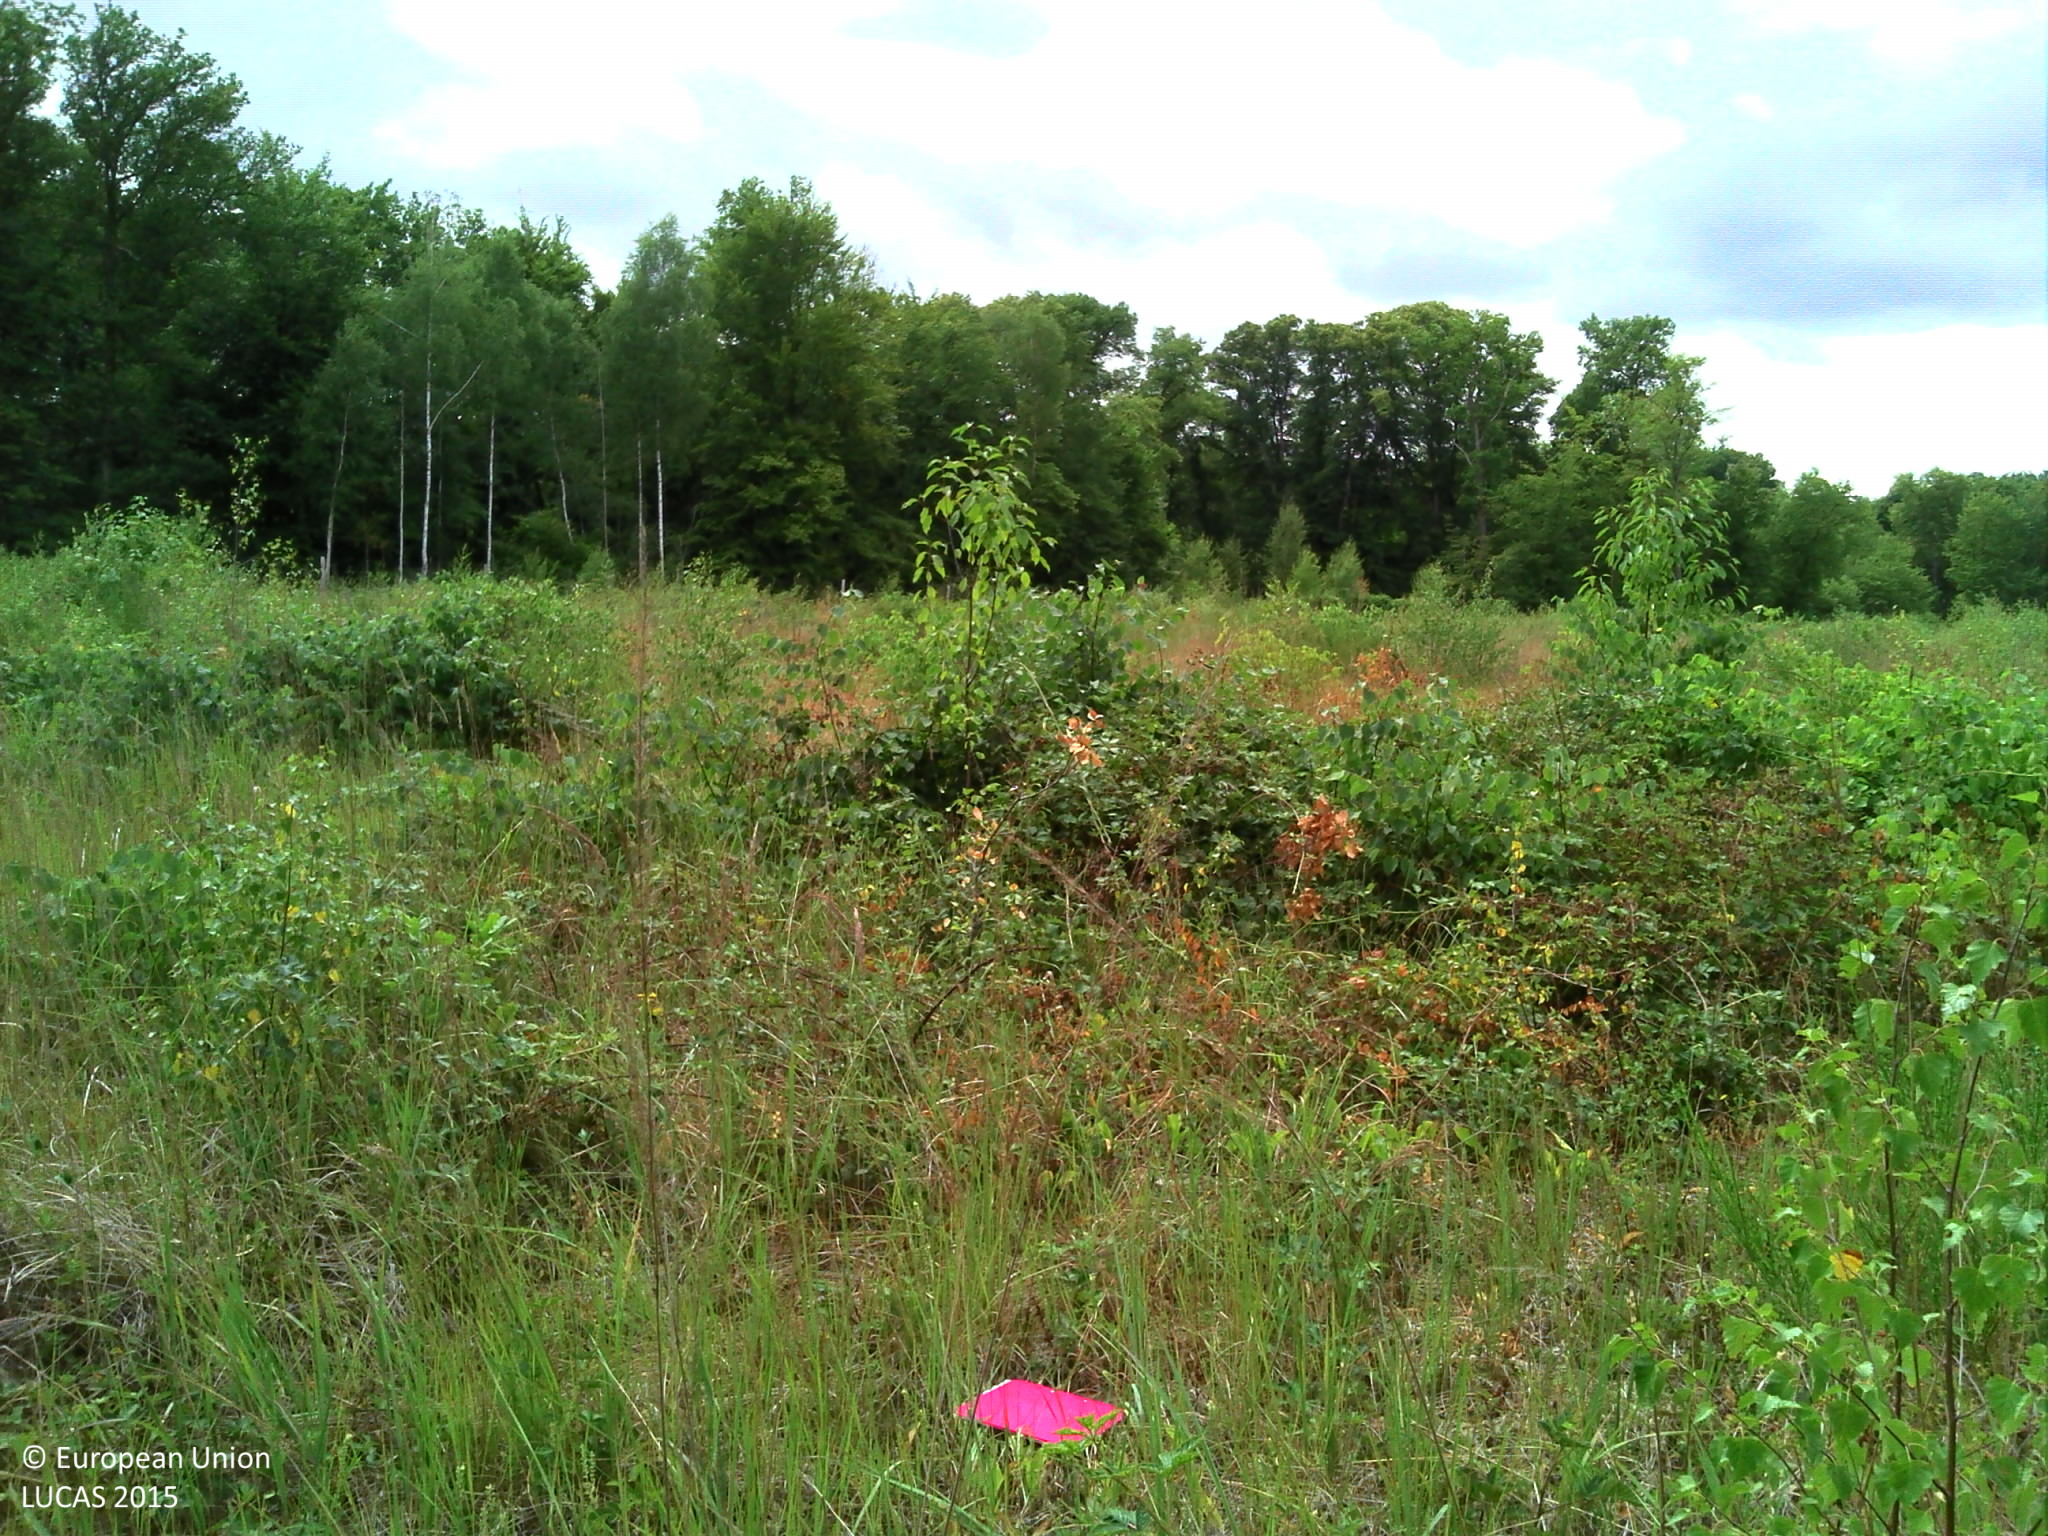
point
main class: Shrubland
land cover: Shrubland with sparse tree cover
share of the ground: > 75 %
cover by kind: shrubs 55 %, herbaceous plants 40 %, broadleaved forest trees 5 %
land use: Semi-natural and natural areas not in use
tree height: < 5 m
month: July
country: FR
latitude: 49.1416
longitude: 2.4901
